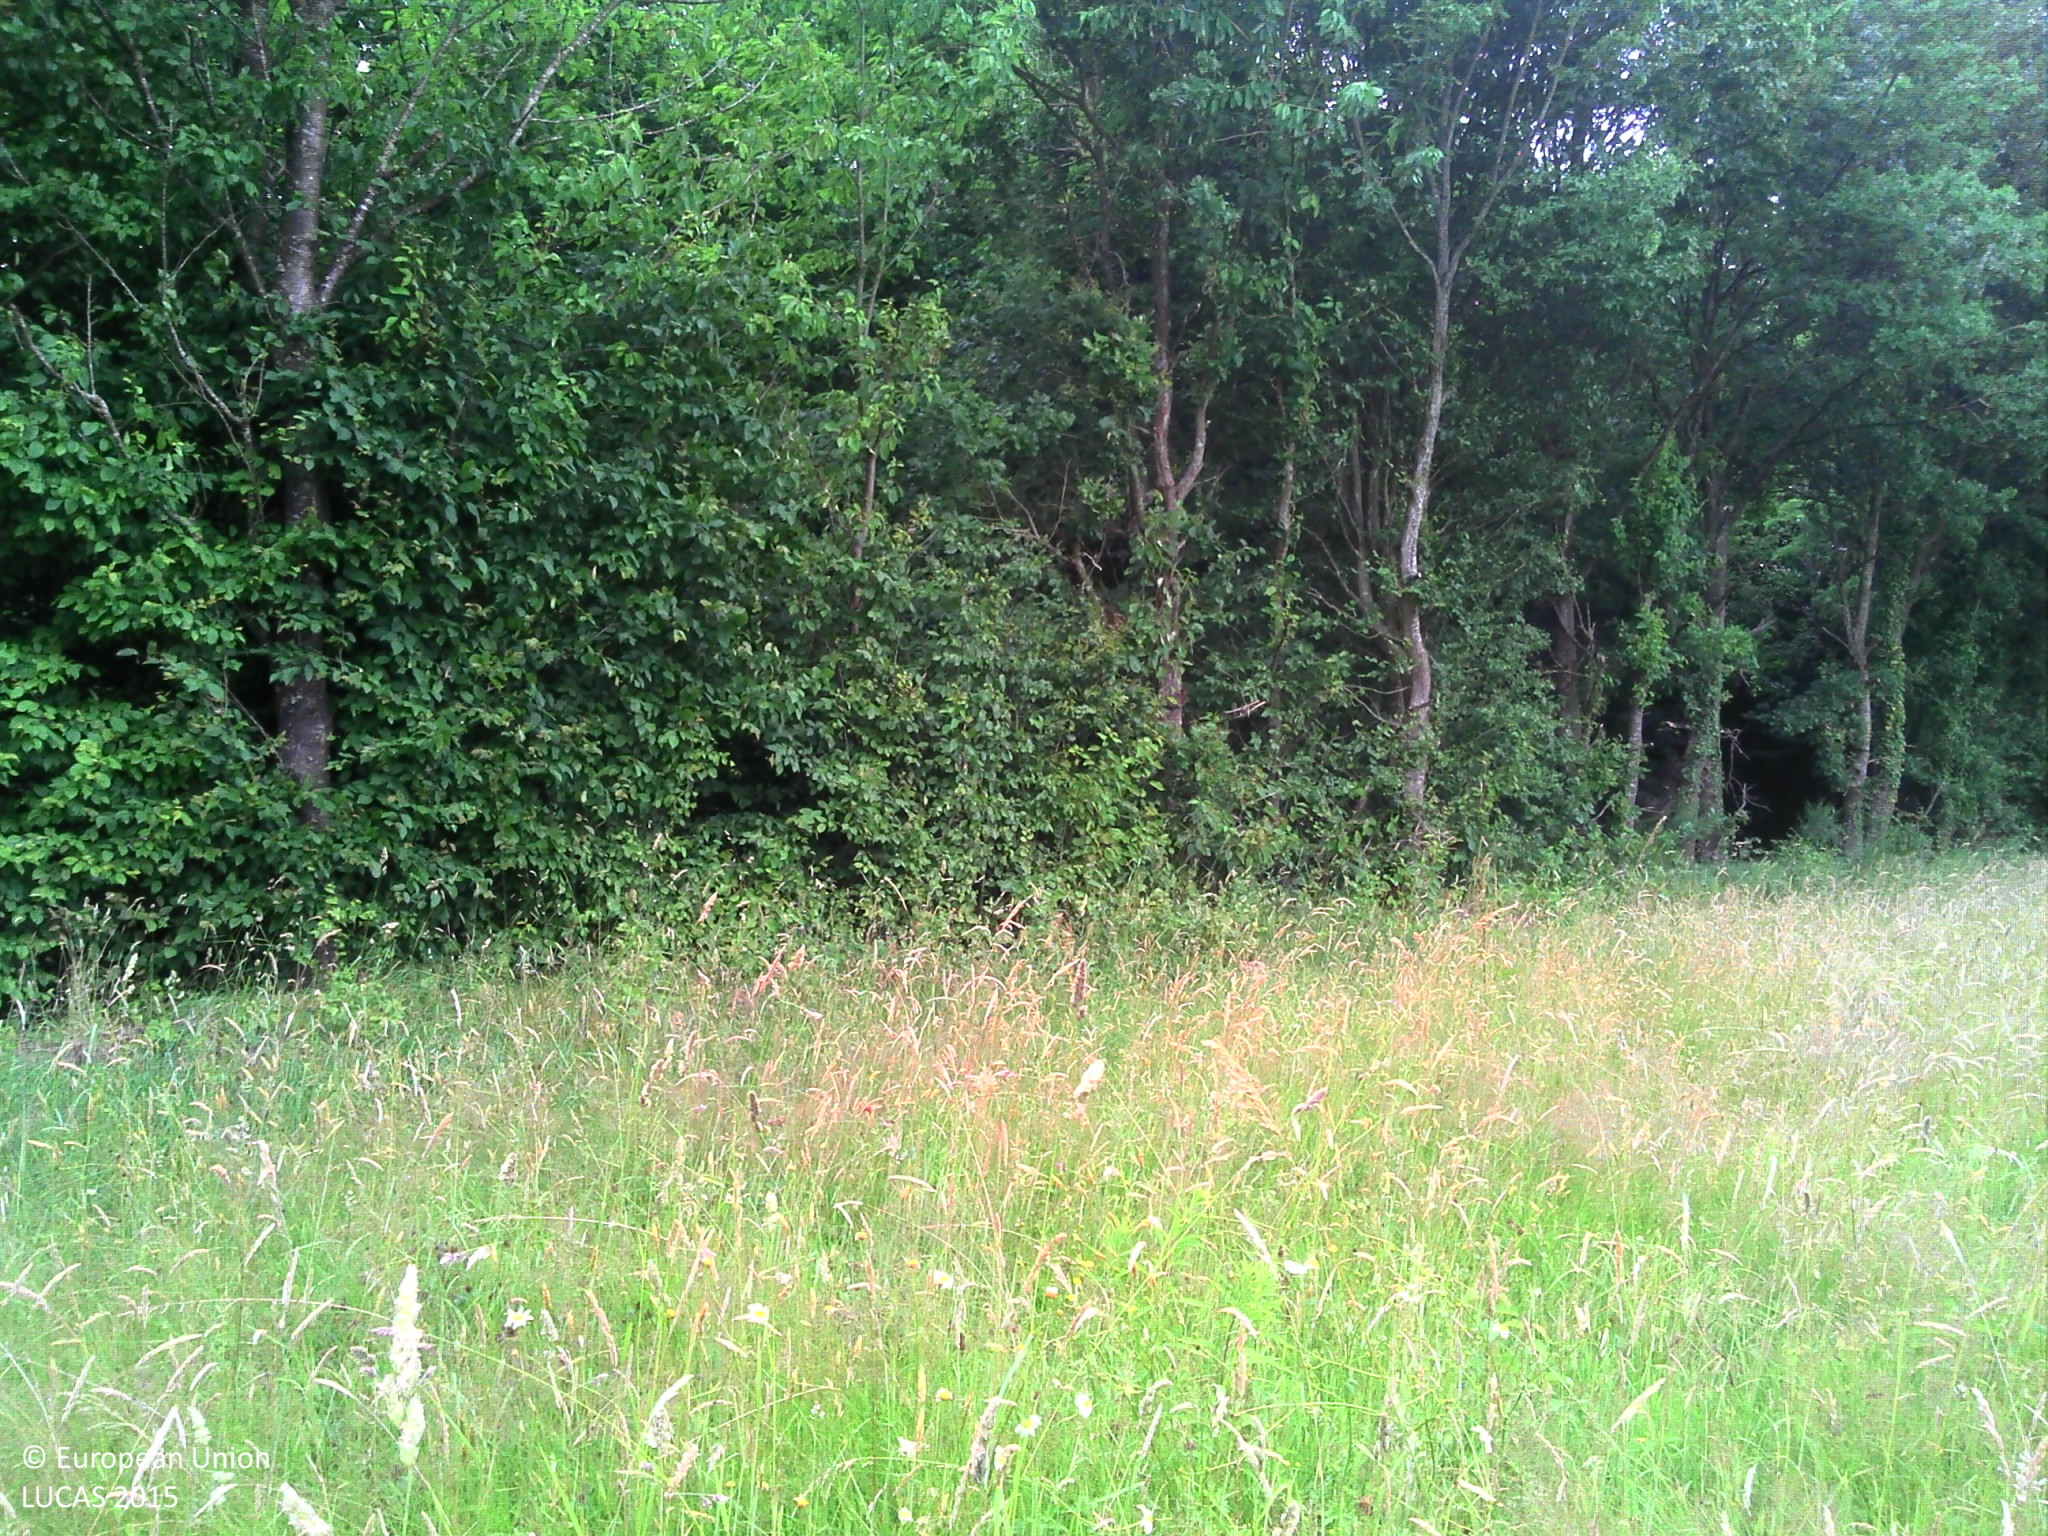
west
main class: Grassland
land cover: Grassland without tree/shrub cover
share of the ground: > 75 %
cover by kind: herbaceous plants 100 %
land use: Agriculture (excluding fallow land and kitchen gardens)
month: June
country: FR
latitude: 46.1029
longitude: 4.8929
